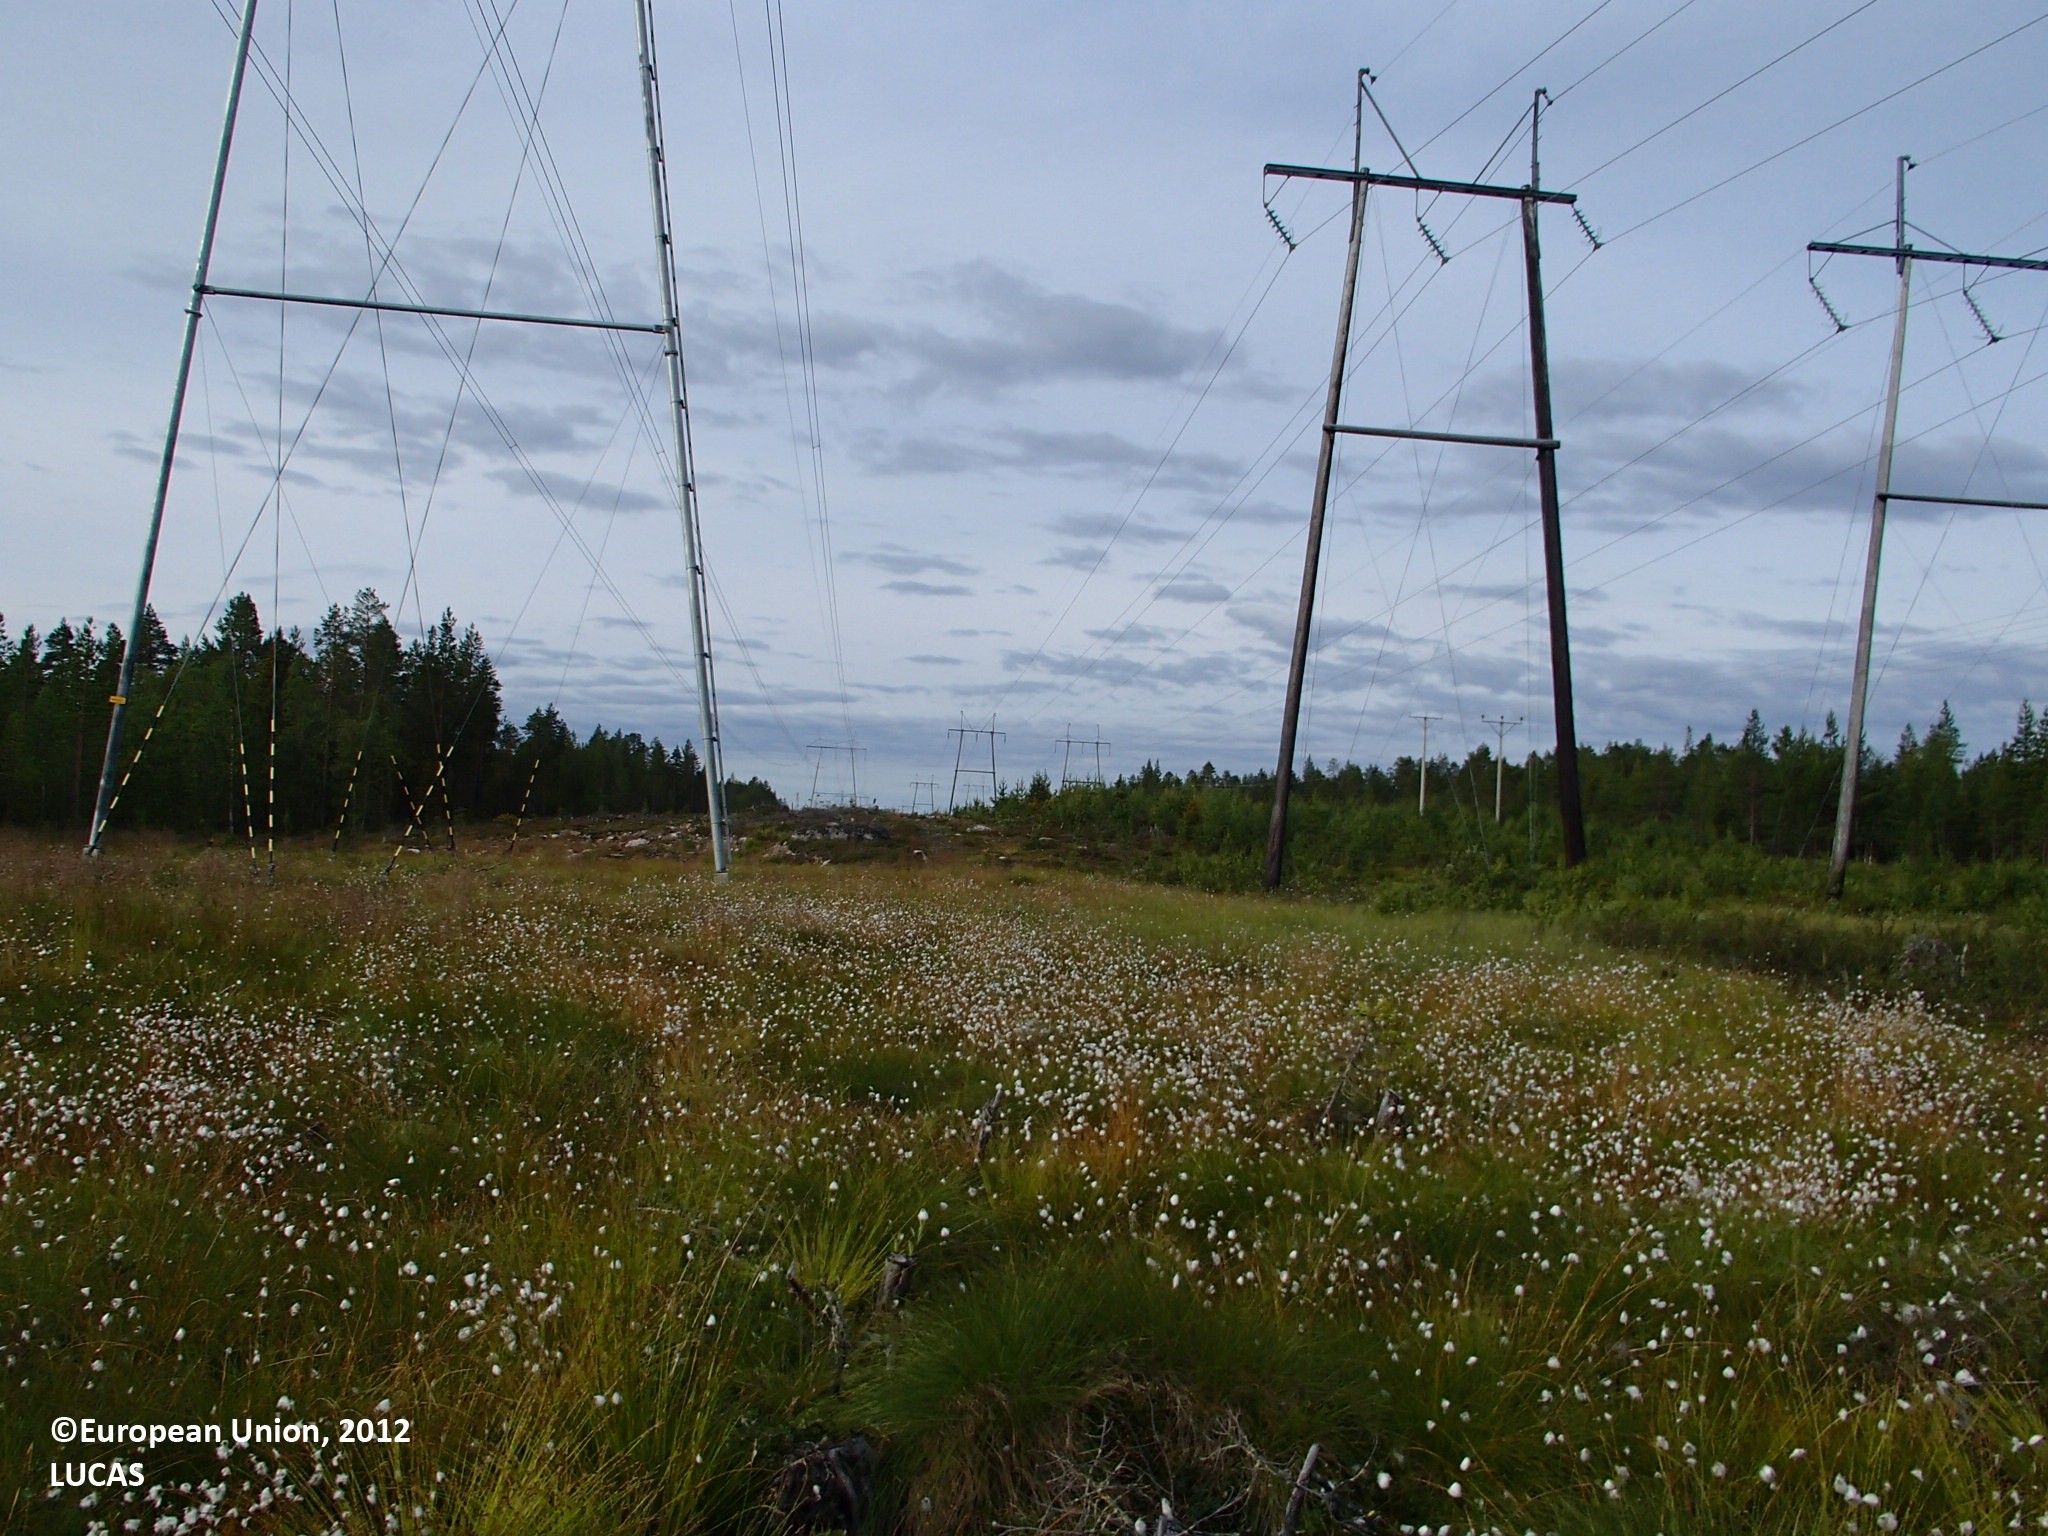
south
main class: Grassland
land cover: Grassland with sparse tree/shrub cover
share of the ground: > 75 %
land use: Energy production
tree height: < 5 m
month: July
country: FI
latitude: 66.4382
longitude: 25.5571
